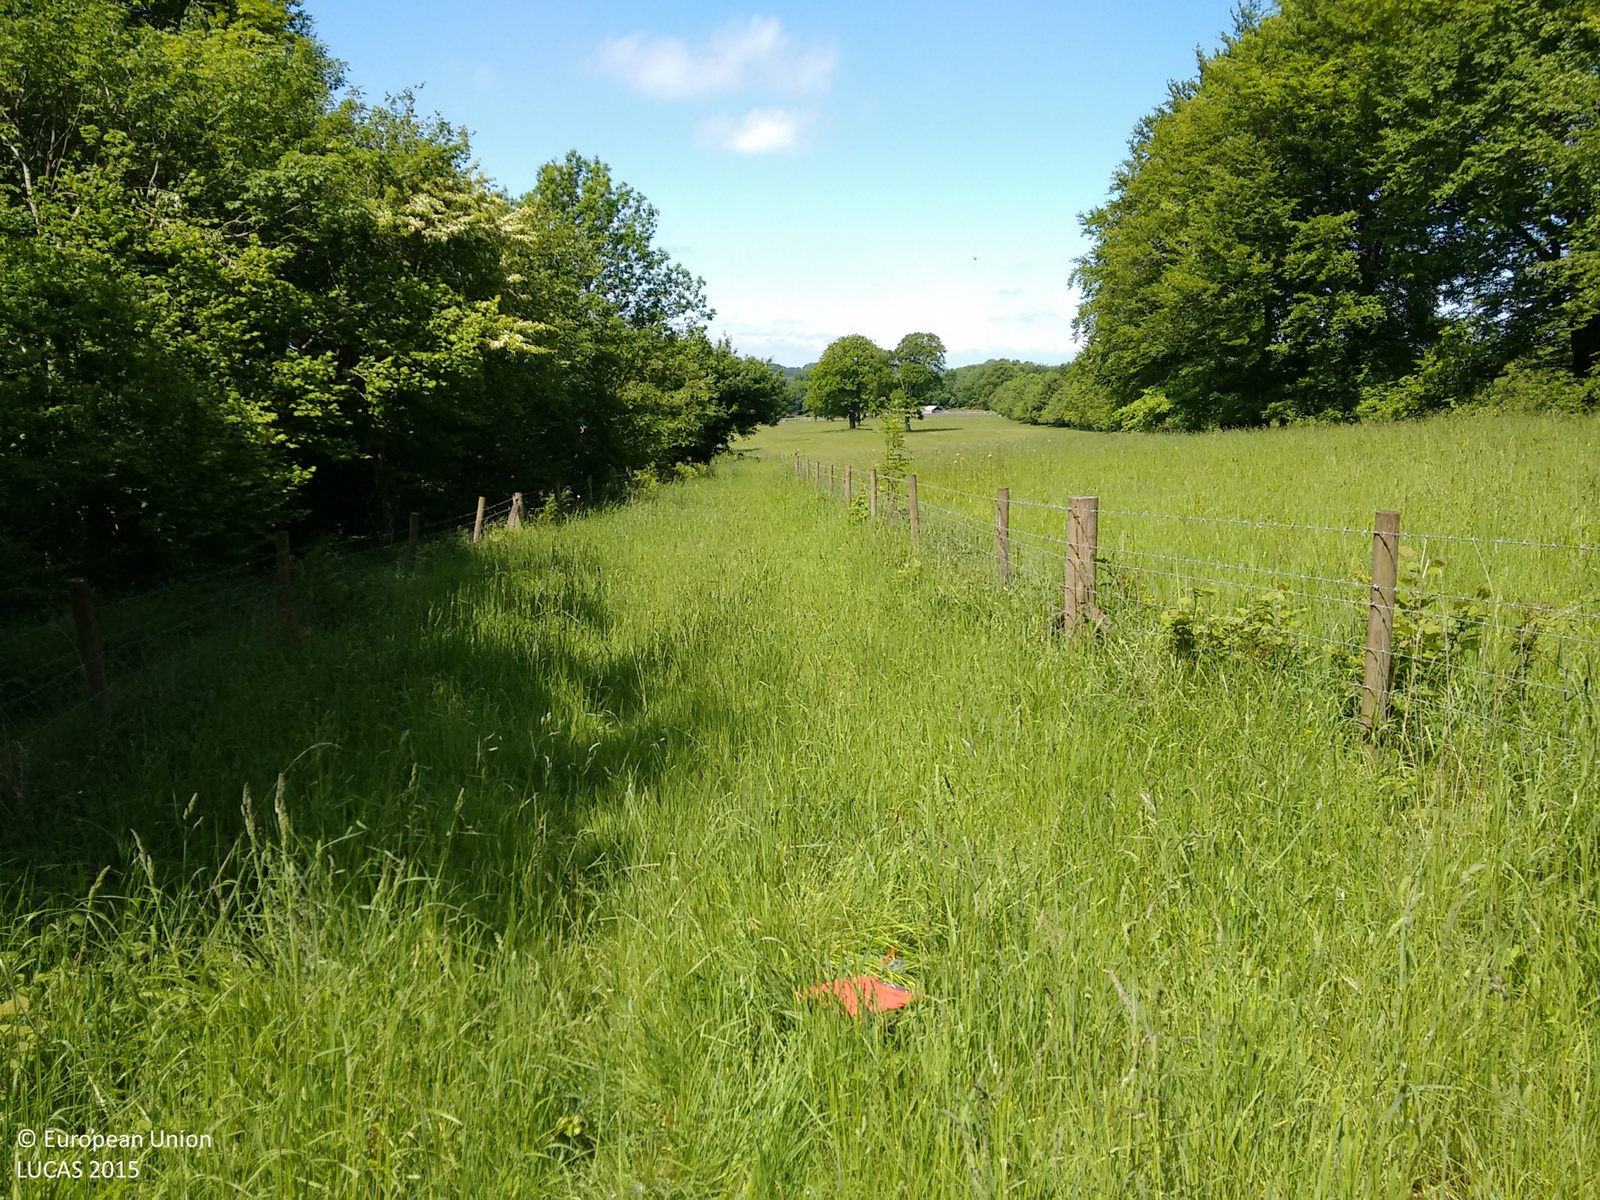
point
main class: Grassland
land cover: Grassland without tree/shrub cover
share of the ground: > 75 %
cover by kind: herbaceous plants 100 %
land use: Agriculture (excluding fallow land and kitchen gardens)
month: June
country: GB
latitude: 51.0775
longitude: -2.1504
